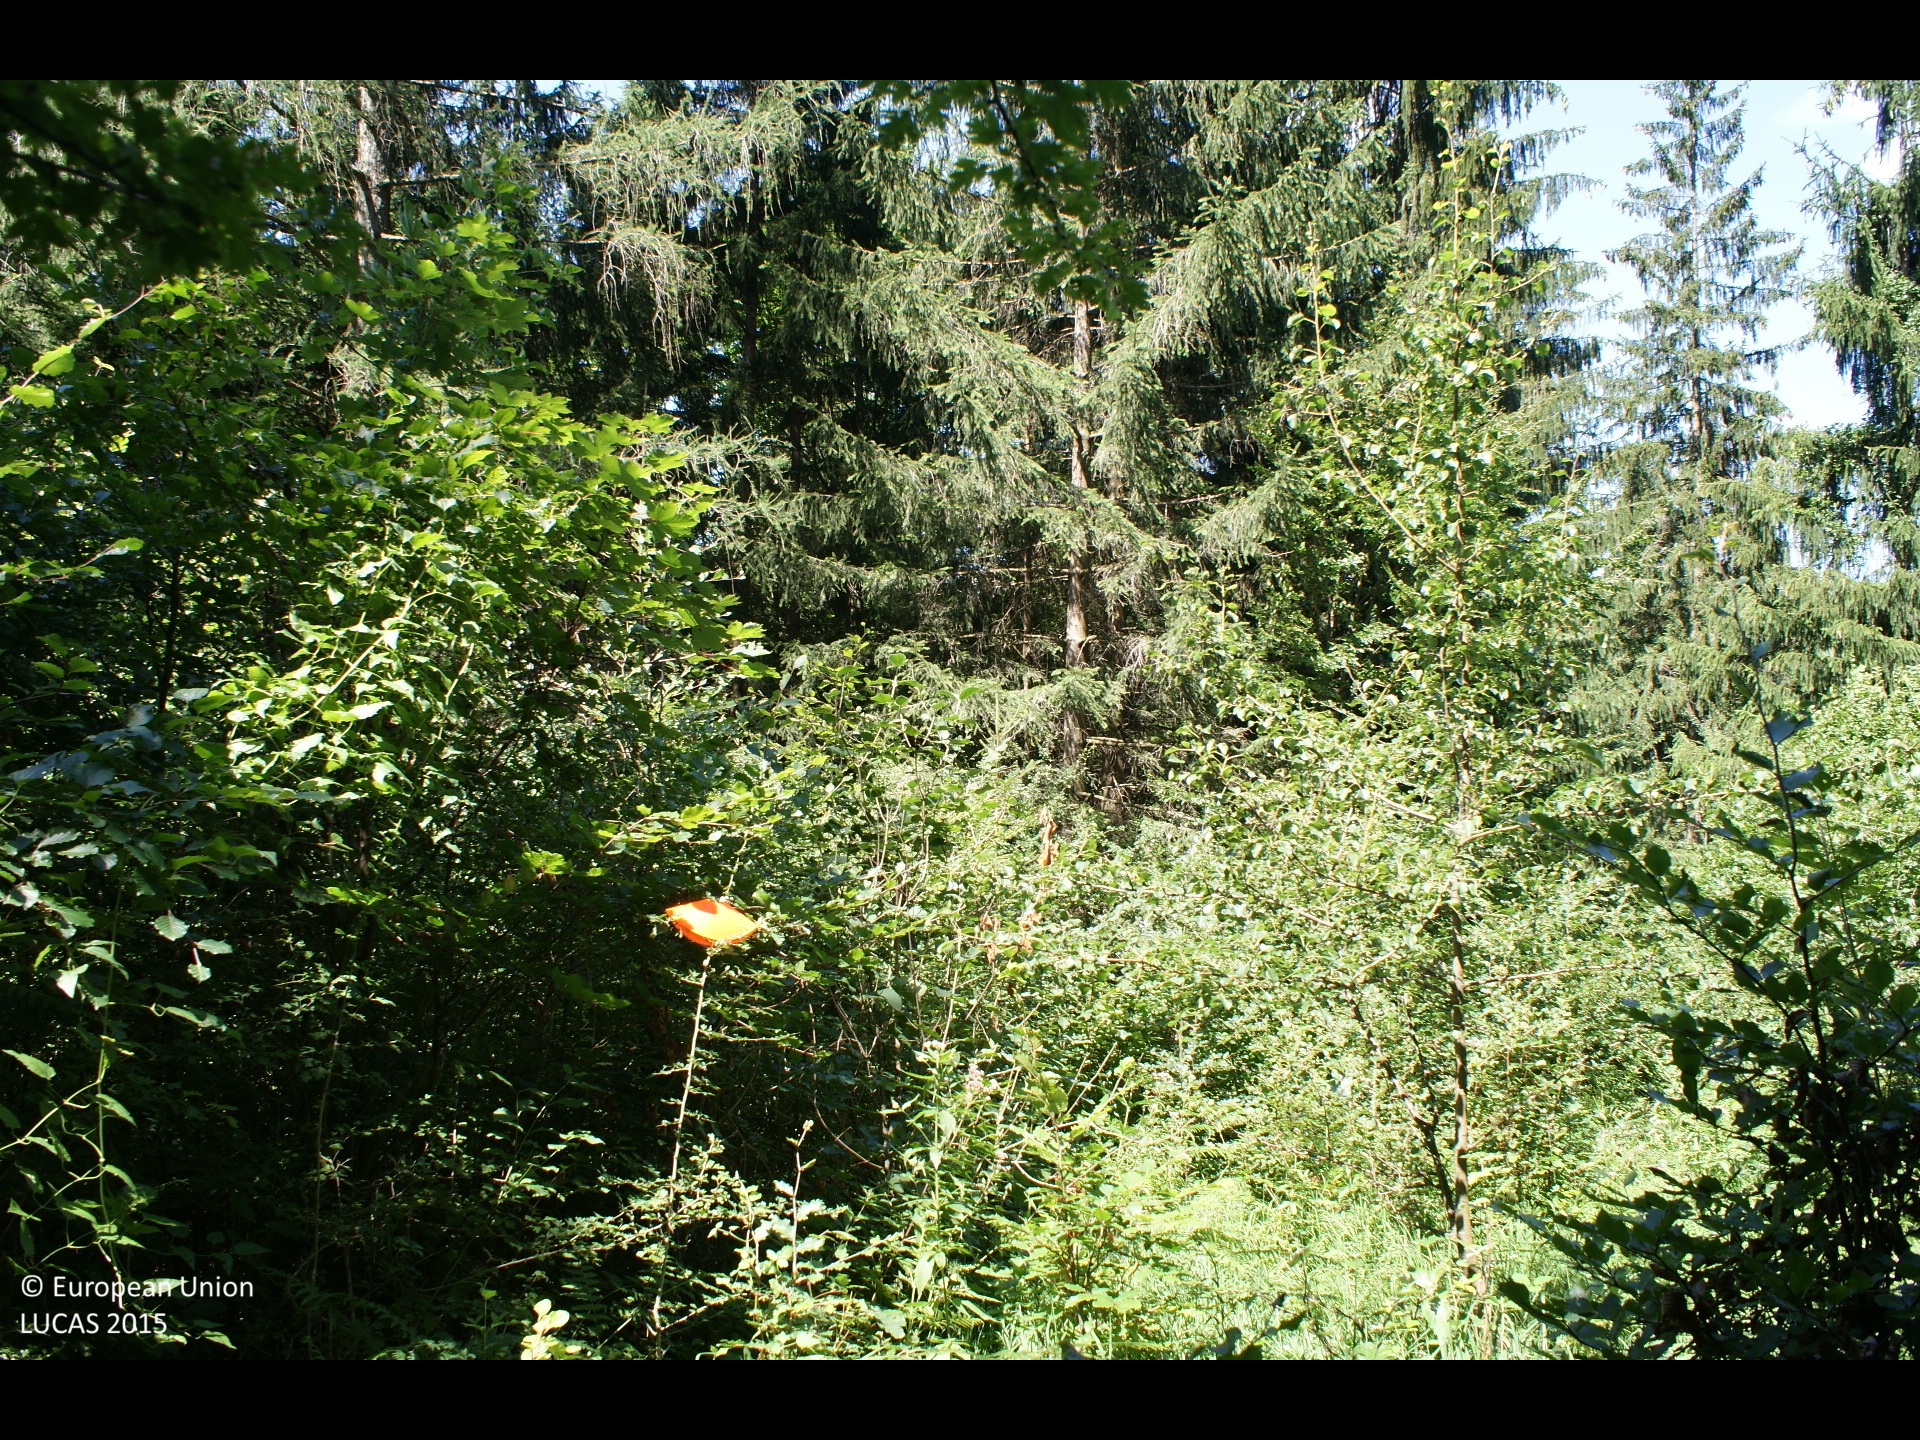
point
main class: Woodland
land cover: Broadleaved woodland
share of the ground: > 75 %
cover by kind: shrubs 40 %, herbaceous plants 30 %, broadleaved forest trees 25 %, coniferous forest trees 5 %
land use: Forestry
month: July
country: AT
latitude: 47.9523
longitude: 15.2905
